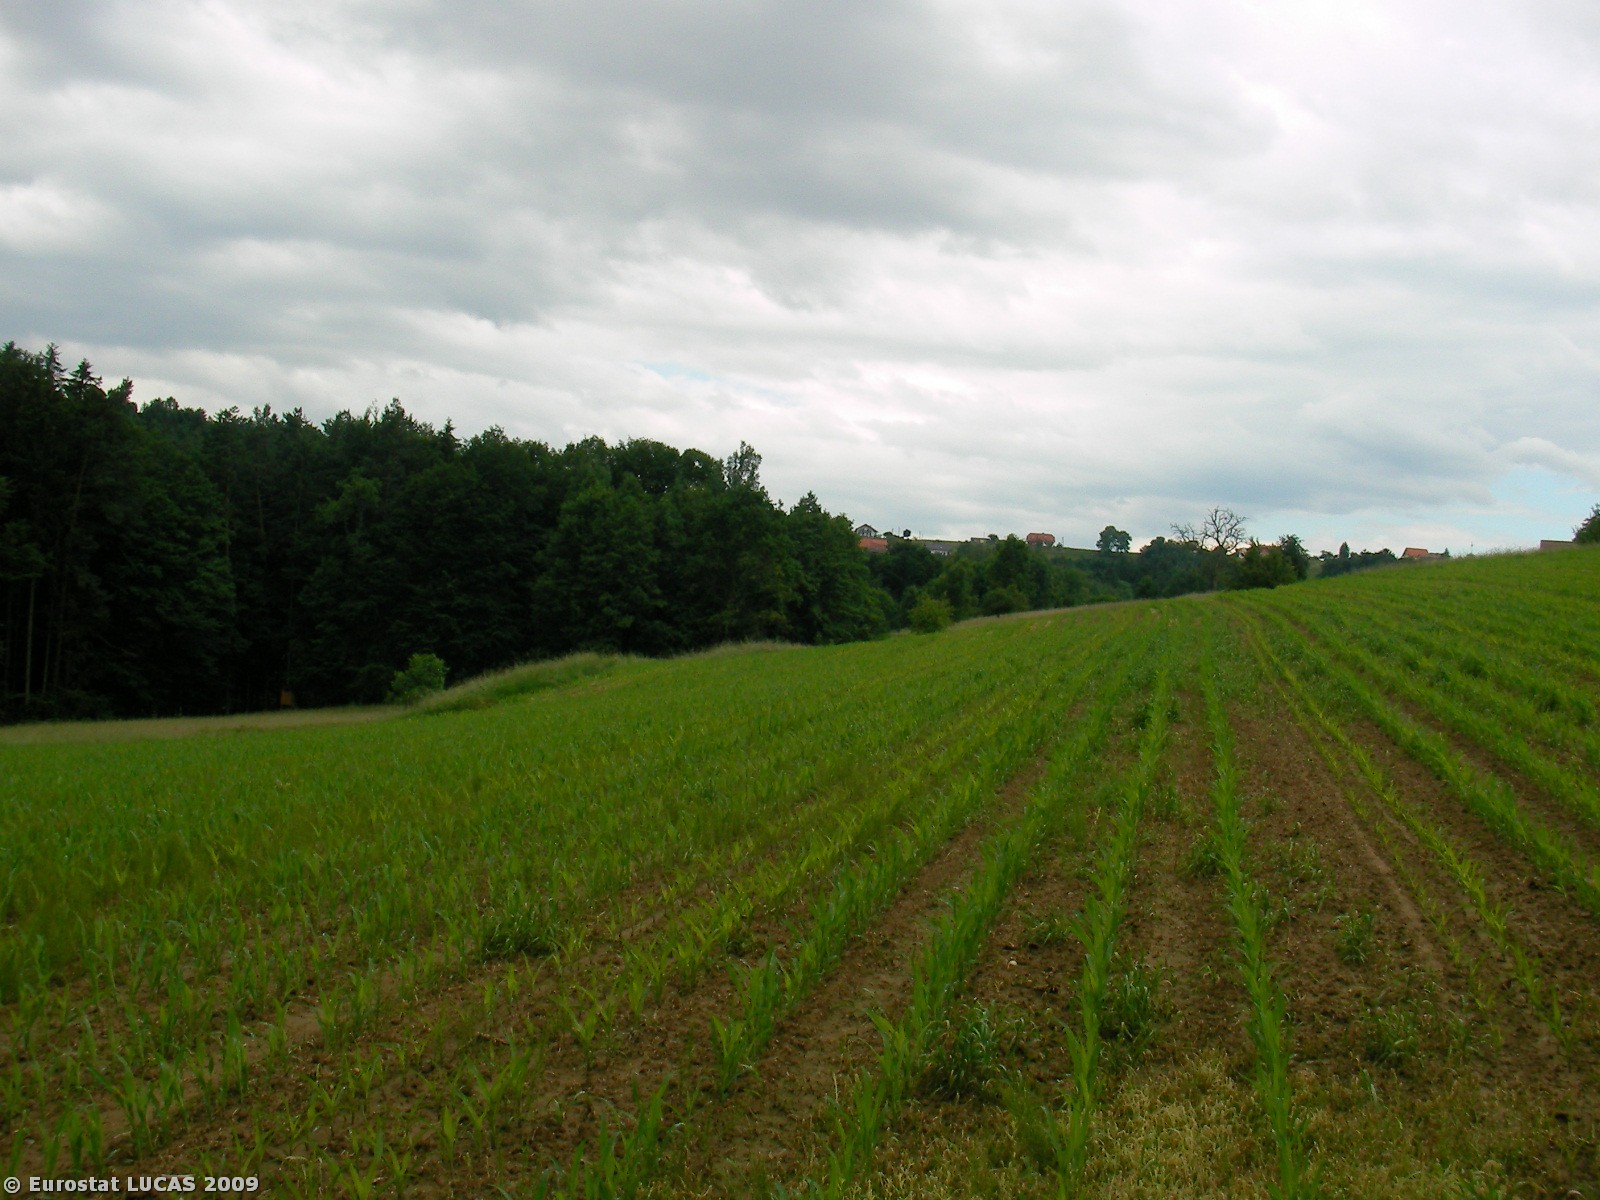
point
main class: Cropland
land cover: Maize
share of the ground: 10 - 25 %
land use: Agriculture (excluding fallow land and kitchen gardens)
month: June
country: AT
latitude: 47.1539
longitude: 15.7379
